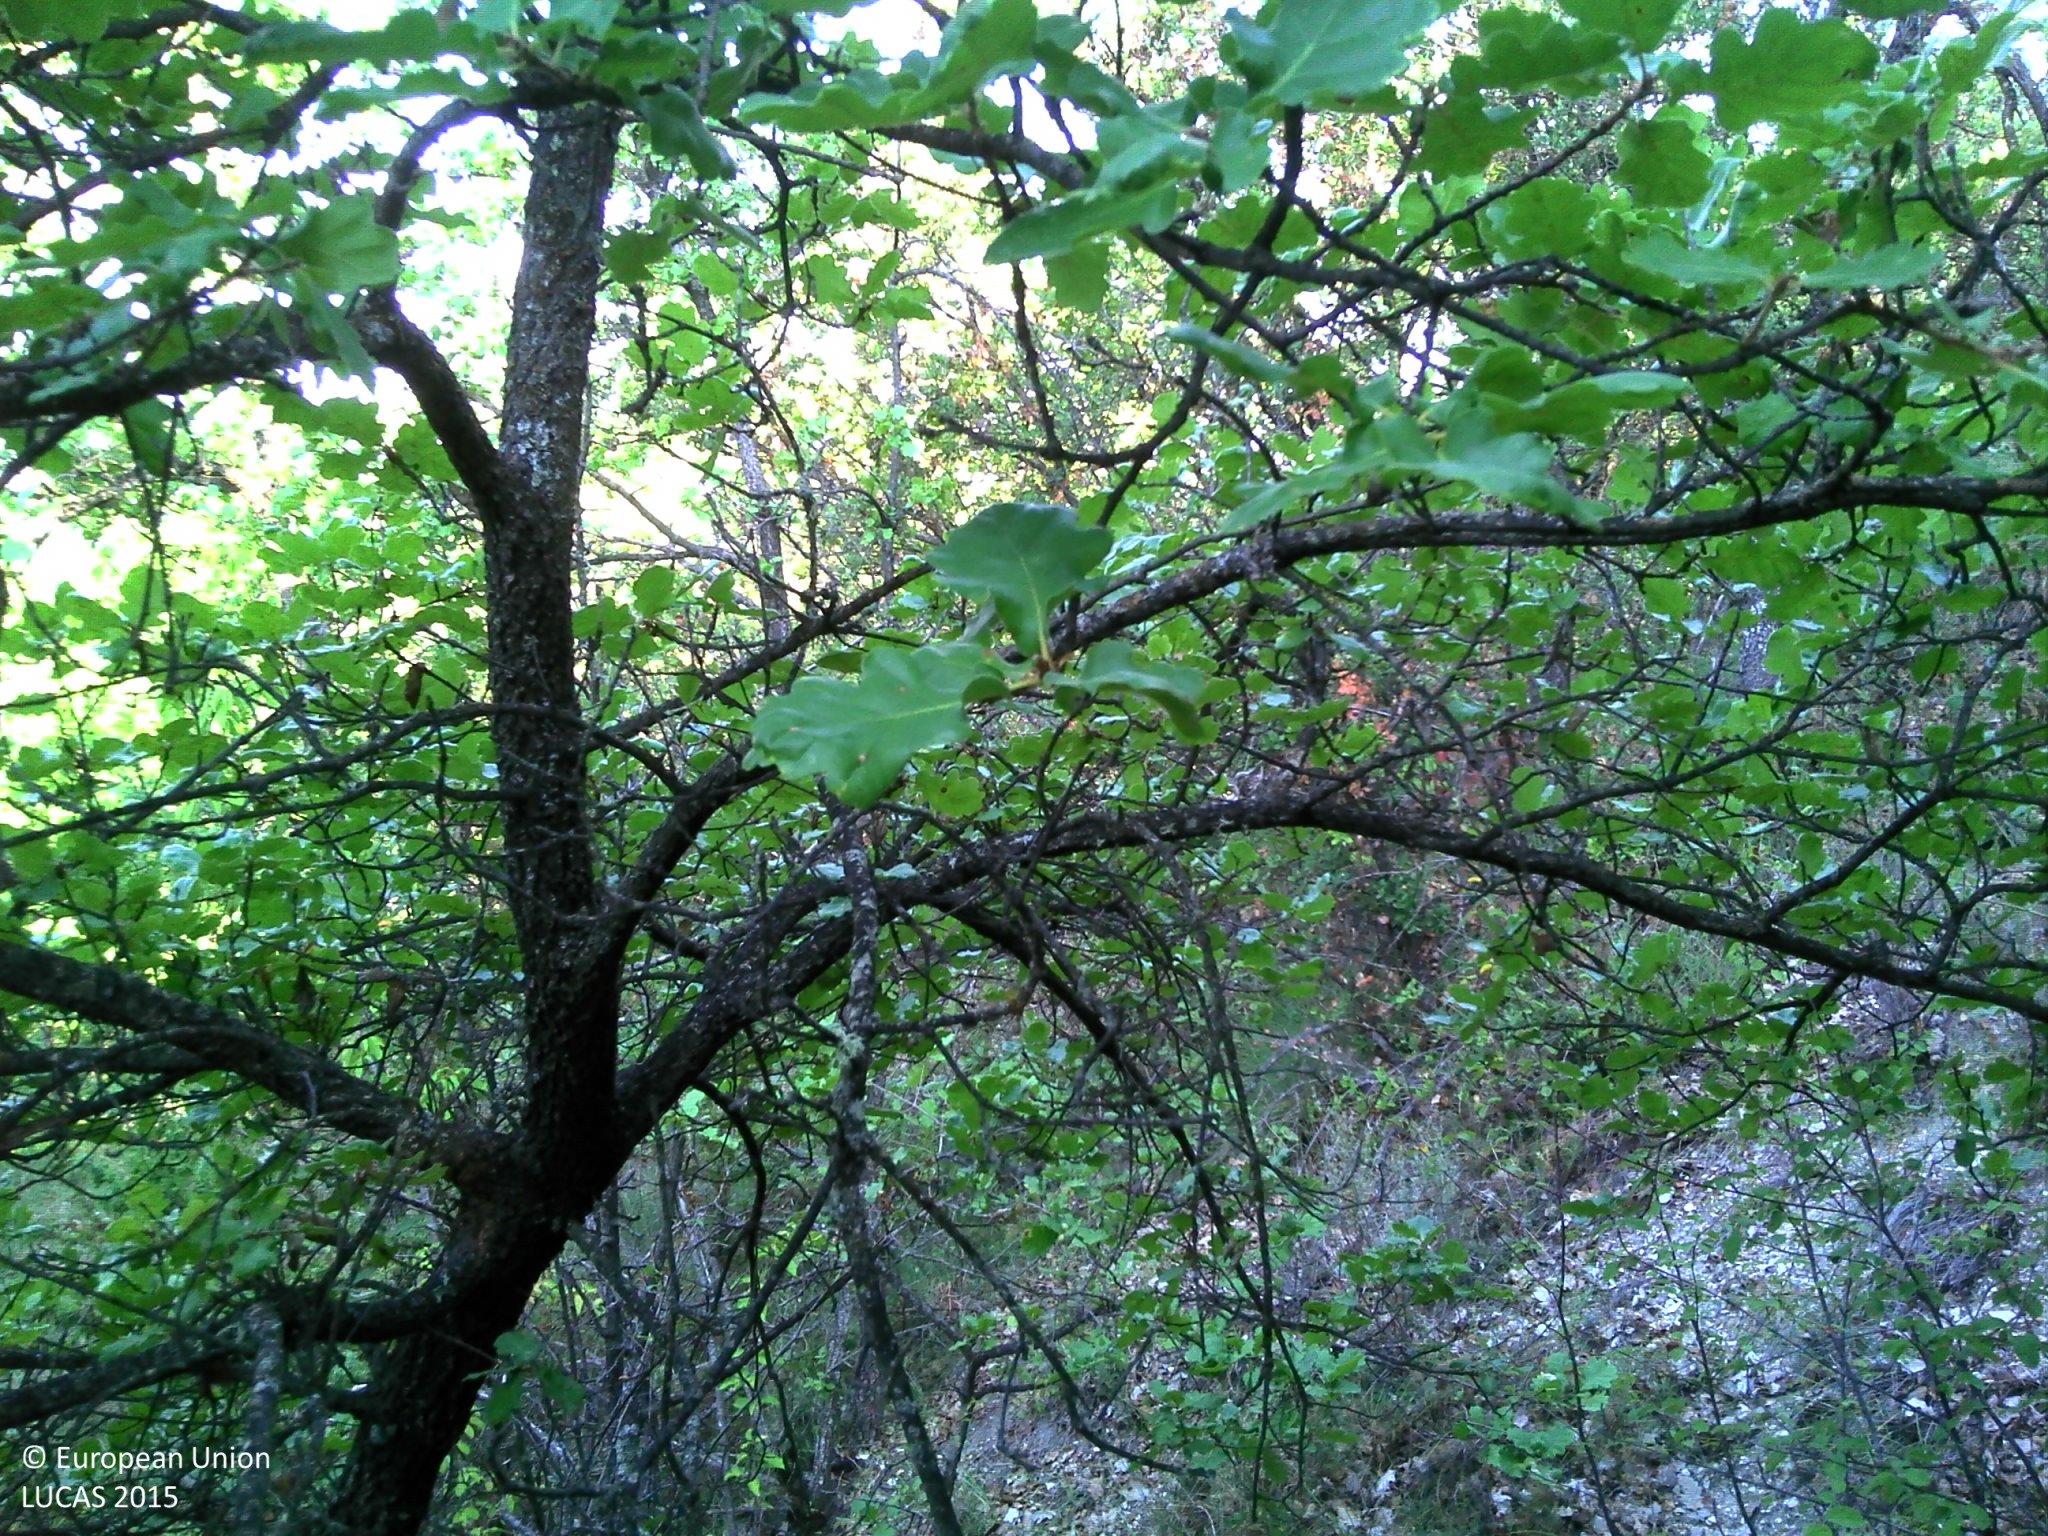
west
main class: Woodland
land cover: Broadleaved woodland
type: broadleaved evergreen forest
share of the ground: > 75 %
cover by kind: broadleaved forest trees 65 %, shrubs 15 %, coniferous forest trees 10 %, herbaceous plants 10 %
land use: Semi-natural and natural areas not in use
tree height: > 5 m
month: August
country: FR
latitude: 43.9218
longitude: 5.3630
